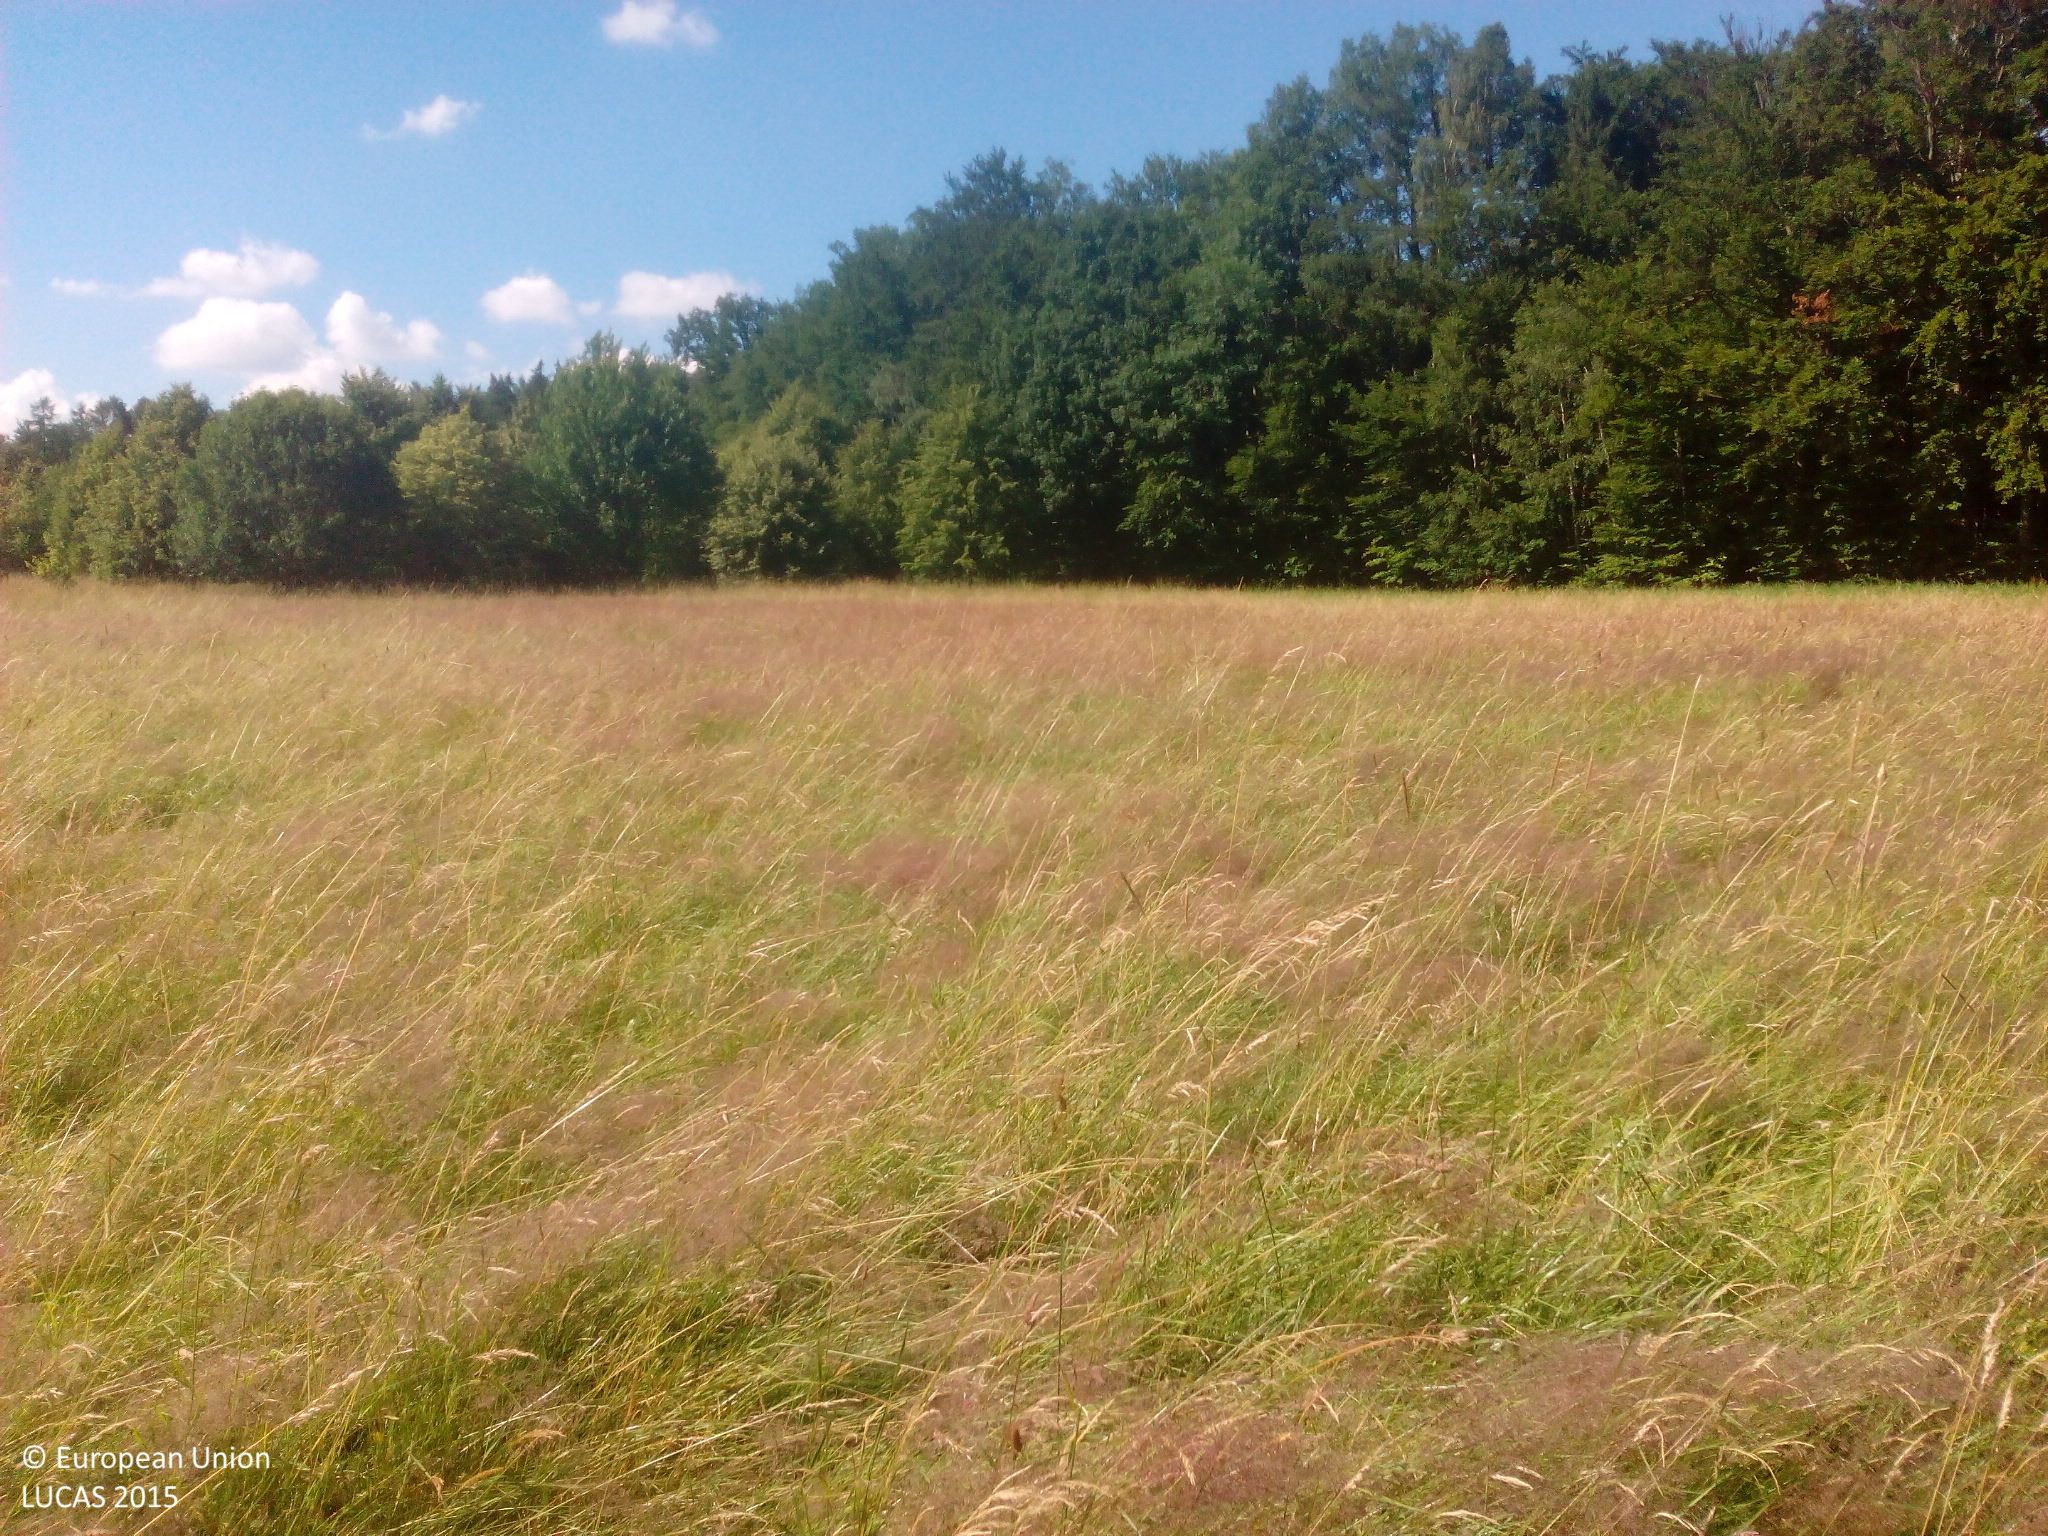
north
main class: Grassland
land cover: Grassland without tree/shrub cover
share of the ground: > 75 %
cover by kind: herbaceous plants 100 %
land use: Agriculture (excluding fallow land and kitchen gardens)
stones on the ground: < 10 %
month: June
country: DE
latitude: 48.5819
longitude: 9.4174
